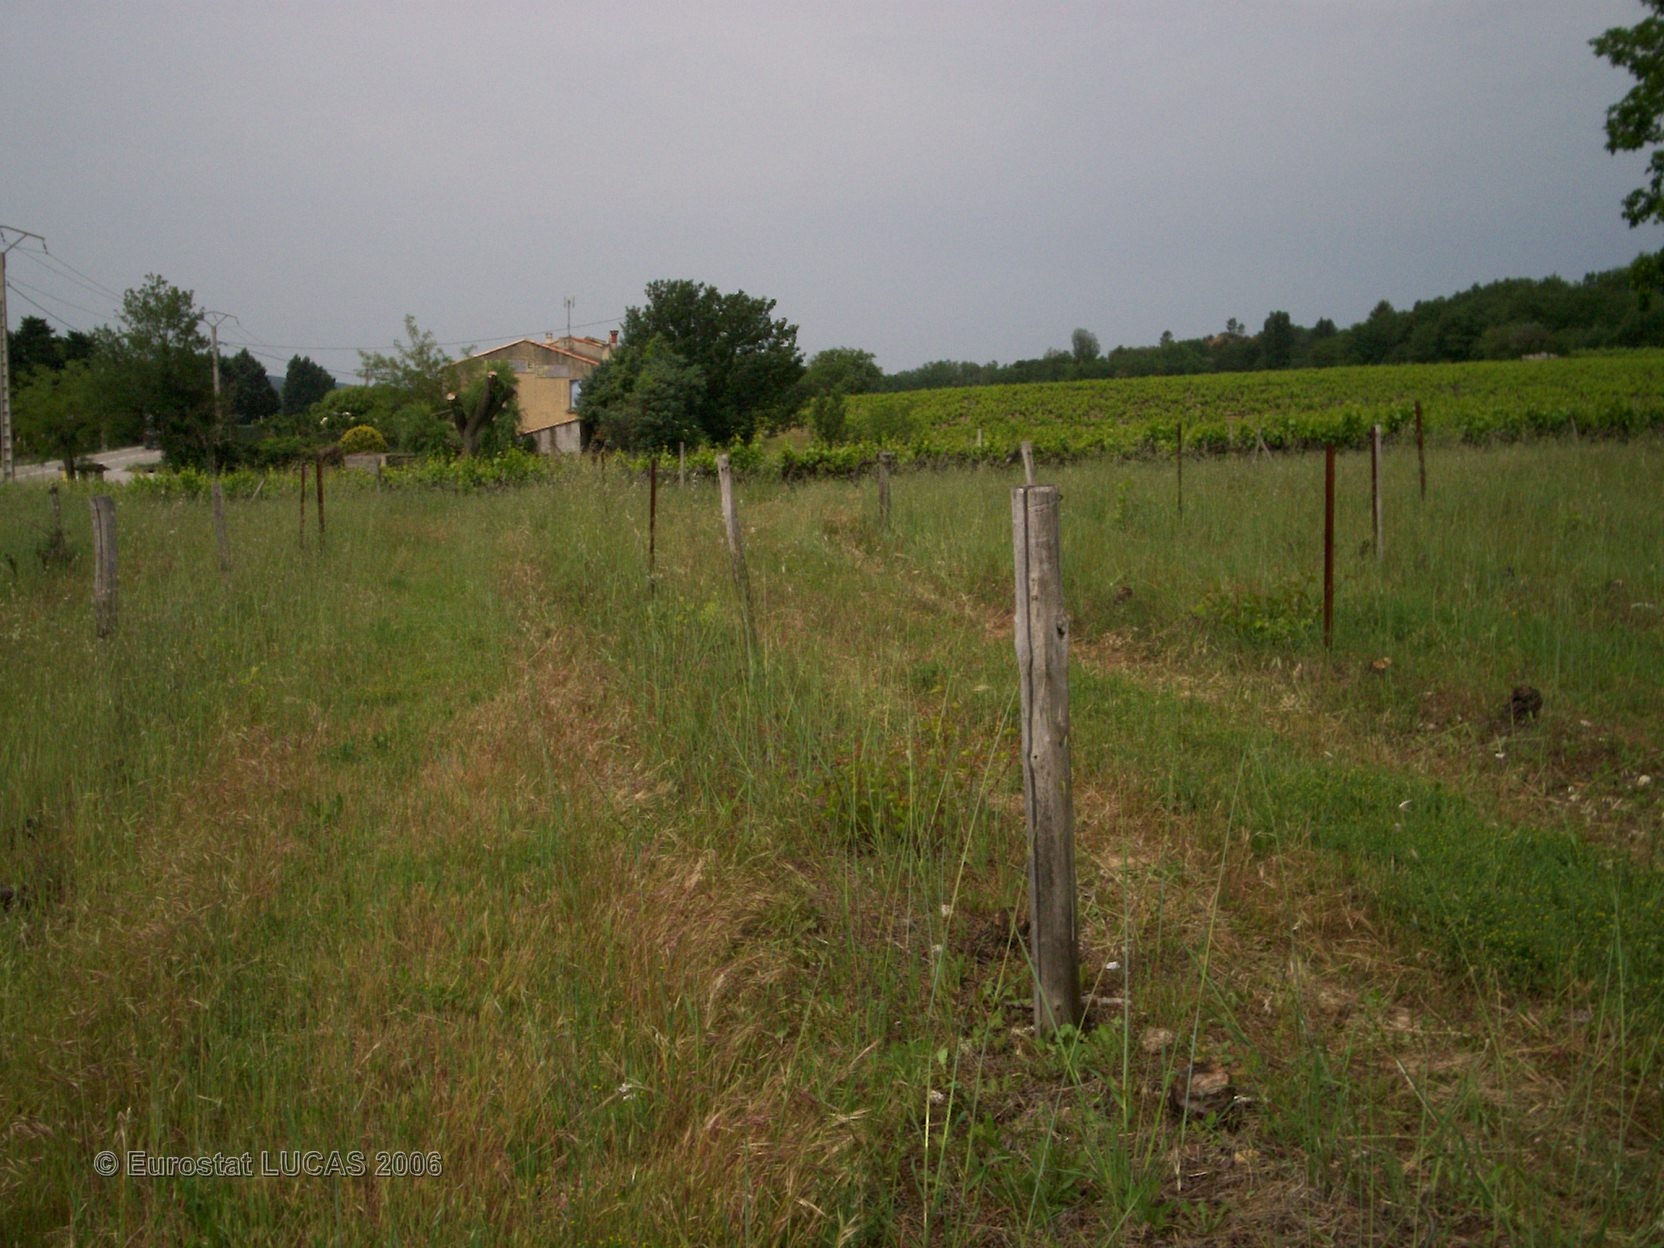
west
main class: Cropland
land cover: Vineyards
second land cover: Grassland with sparse tree/shrub cover
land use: Agriculture (excluding fallow land and kitchen gardens)
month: May
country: FR
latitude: 44.4212
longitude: 4.8450
